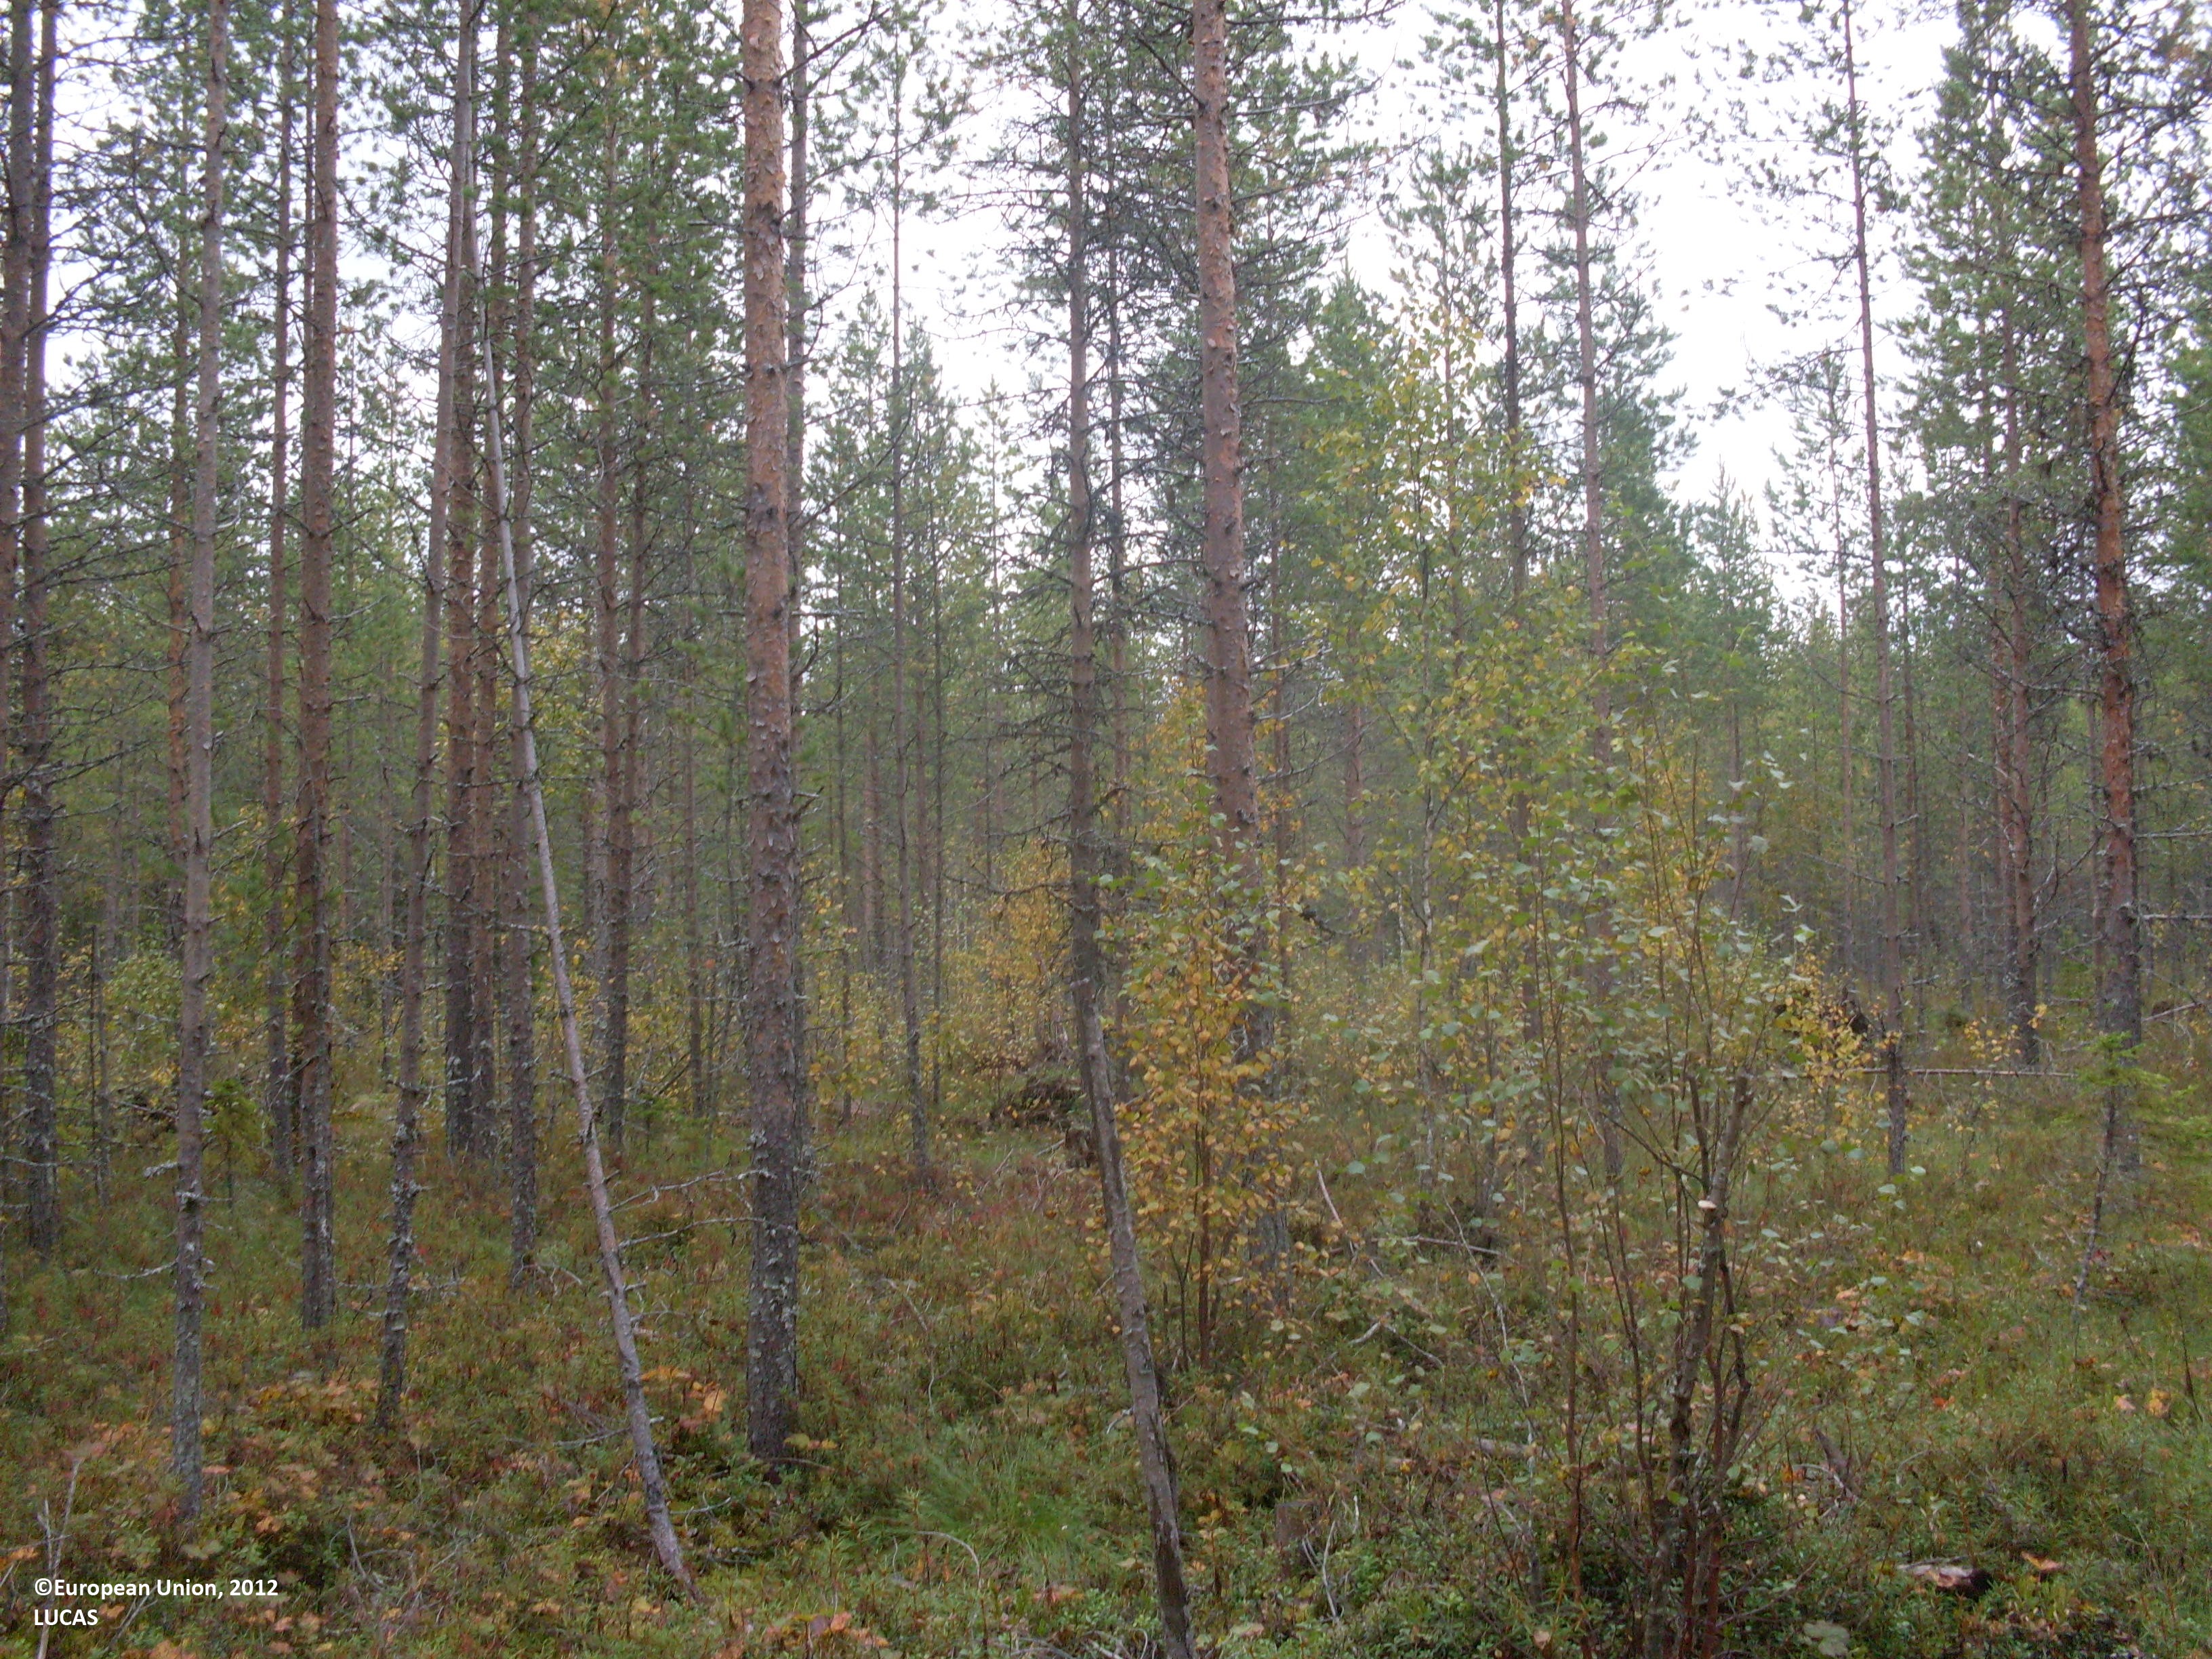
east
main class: Woodland
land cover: Pine dominated coniferous woodland
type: boreal forest
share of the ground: > 75 %
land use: Forestry
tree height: > 5 m
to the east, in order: Pine dominated coniferous woodland; Ditches and canals; Pine dominated mixed woodland
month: September
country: FI
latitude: 64.0416
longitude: 29.7010
